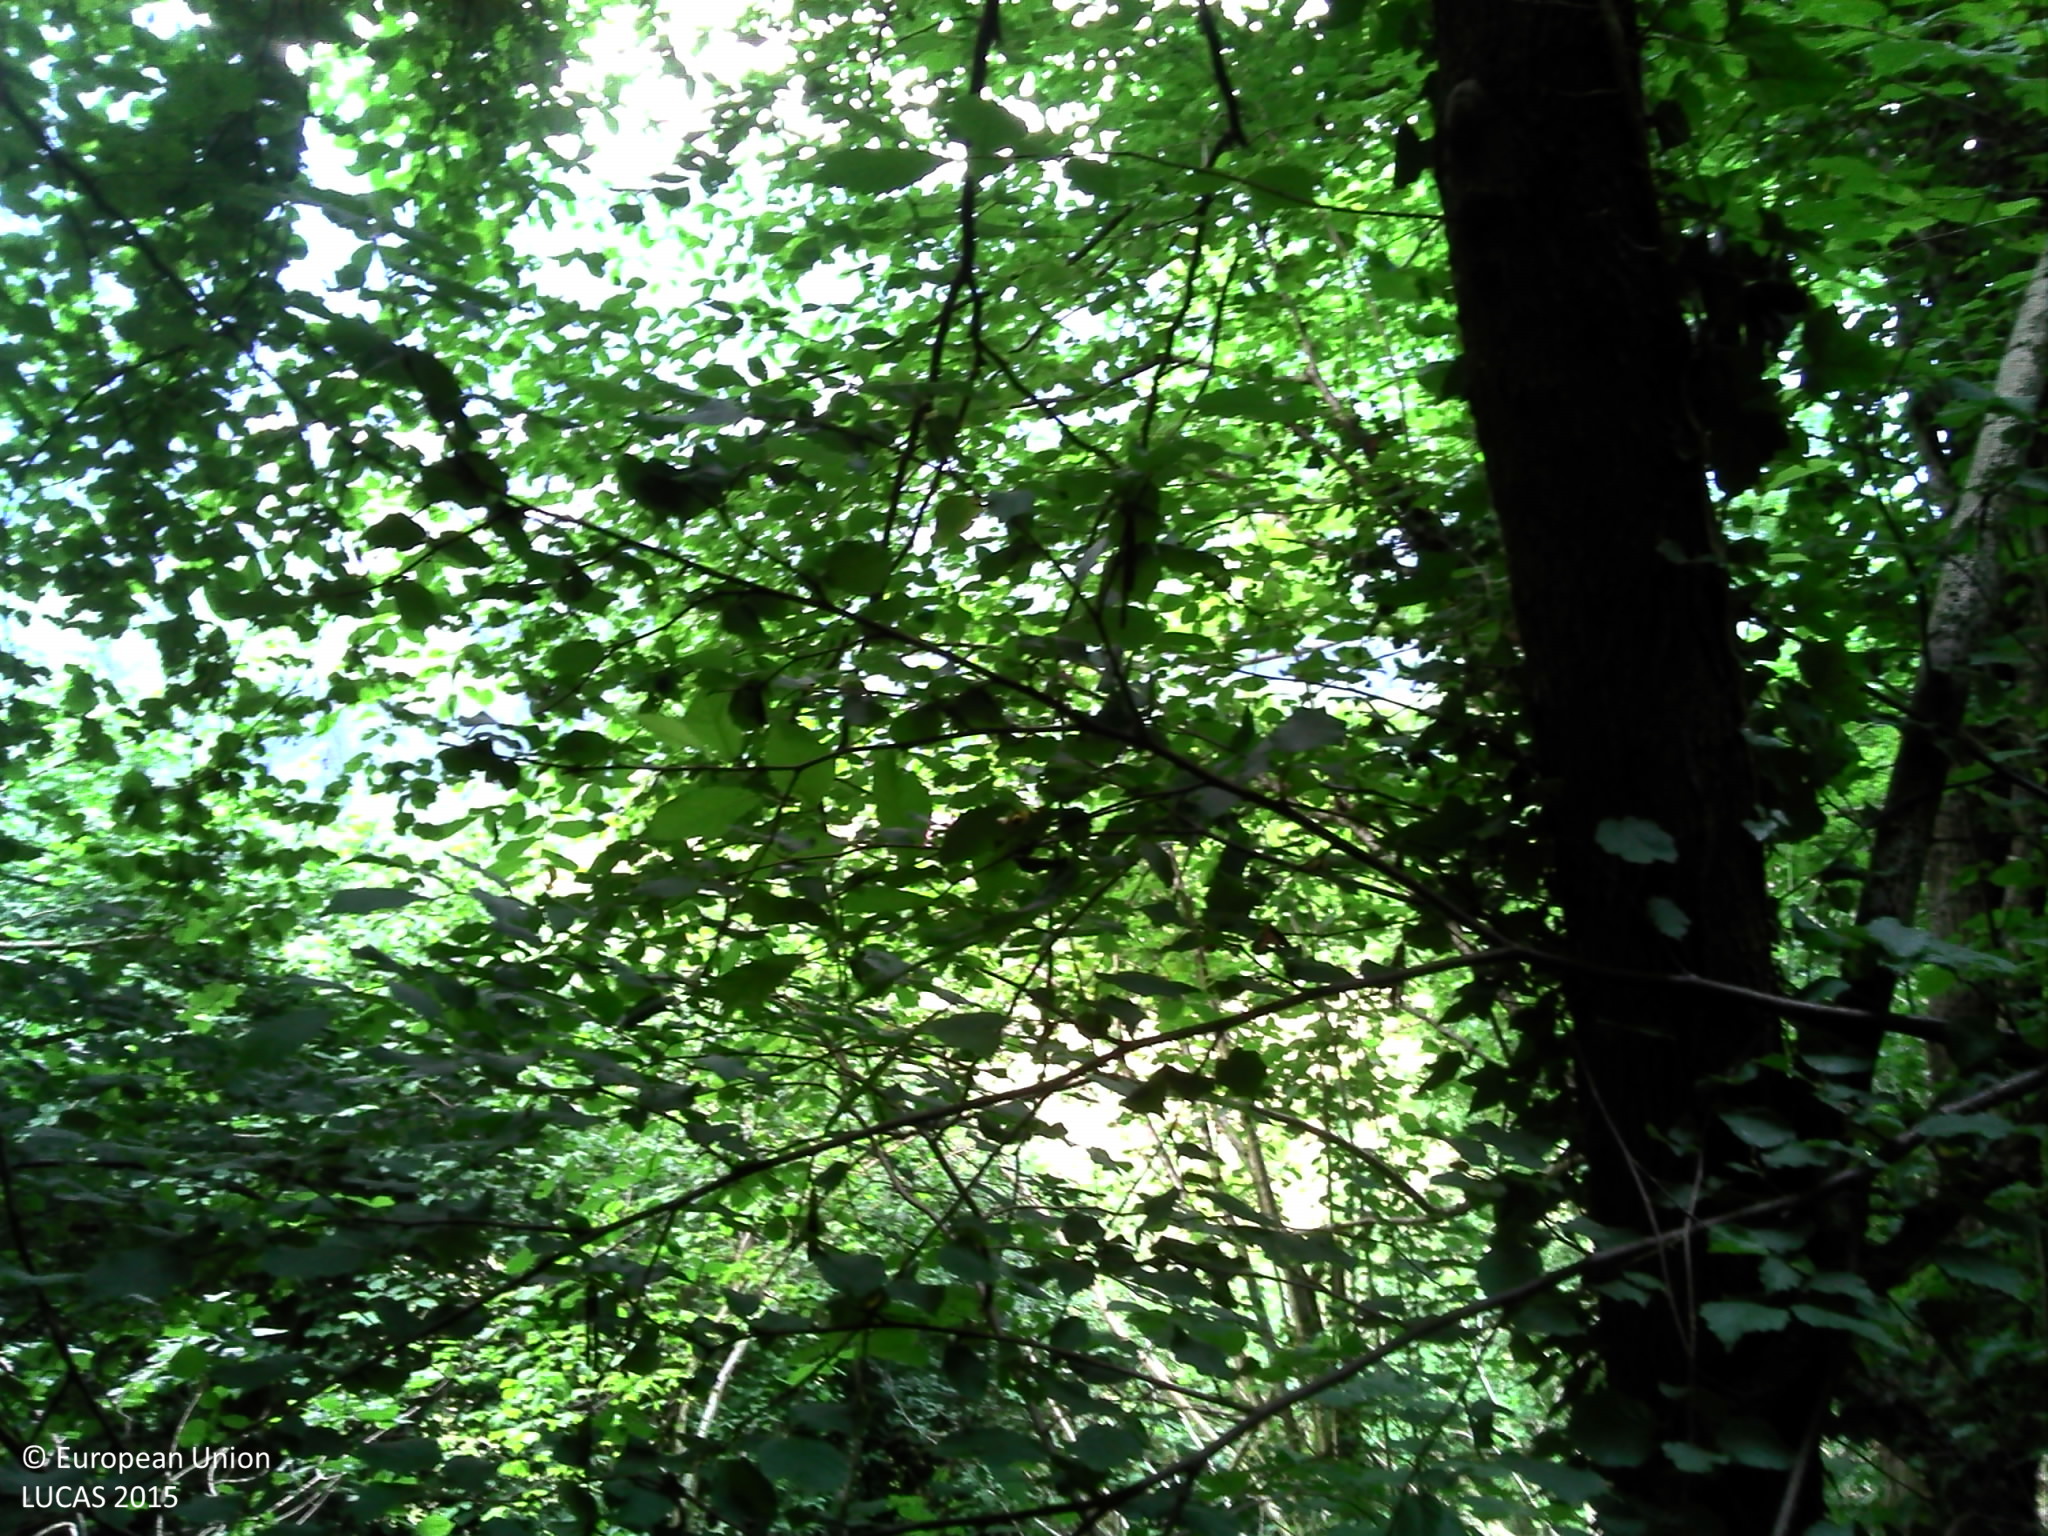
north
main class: Woodland
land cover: Broadleaved woodland
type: mesophytic deciduous forest
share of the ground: > 75 %
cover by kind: broadleaved forest trees 90 %, shrubs 5 %, herbaceous plants 5 %
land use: Forestry
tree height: > 5 m
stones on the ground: 10 - 25 %
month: July
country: FR
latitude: 42.9823
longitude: -0.1198
